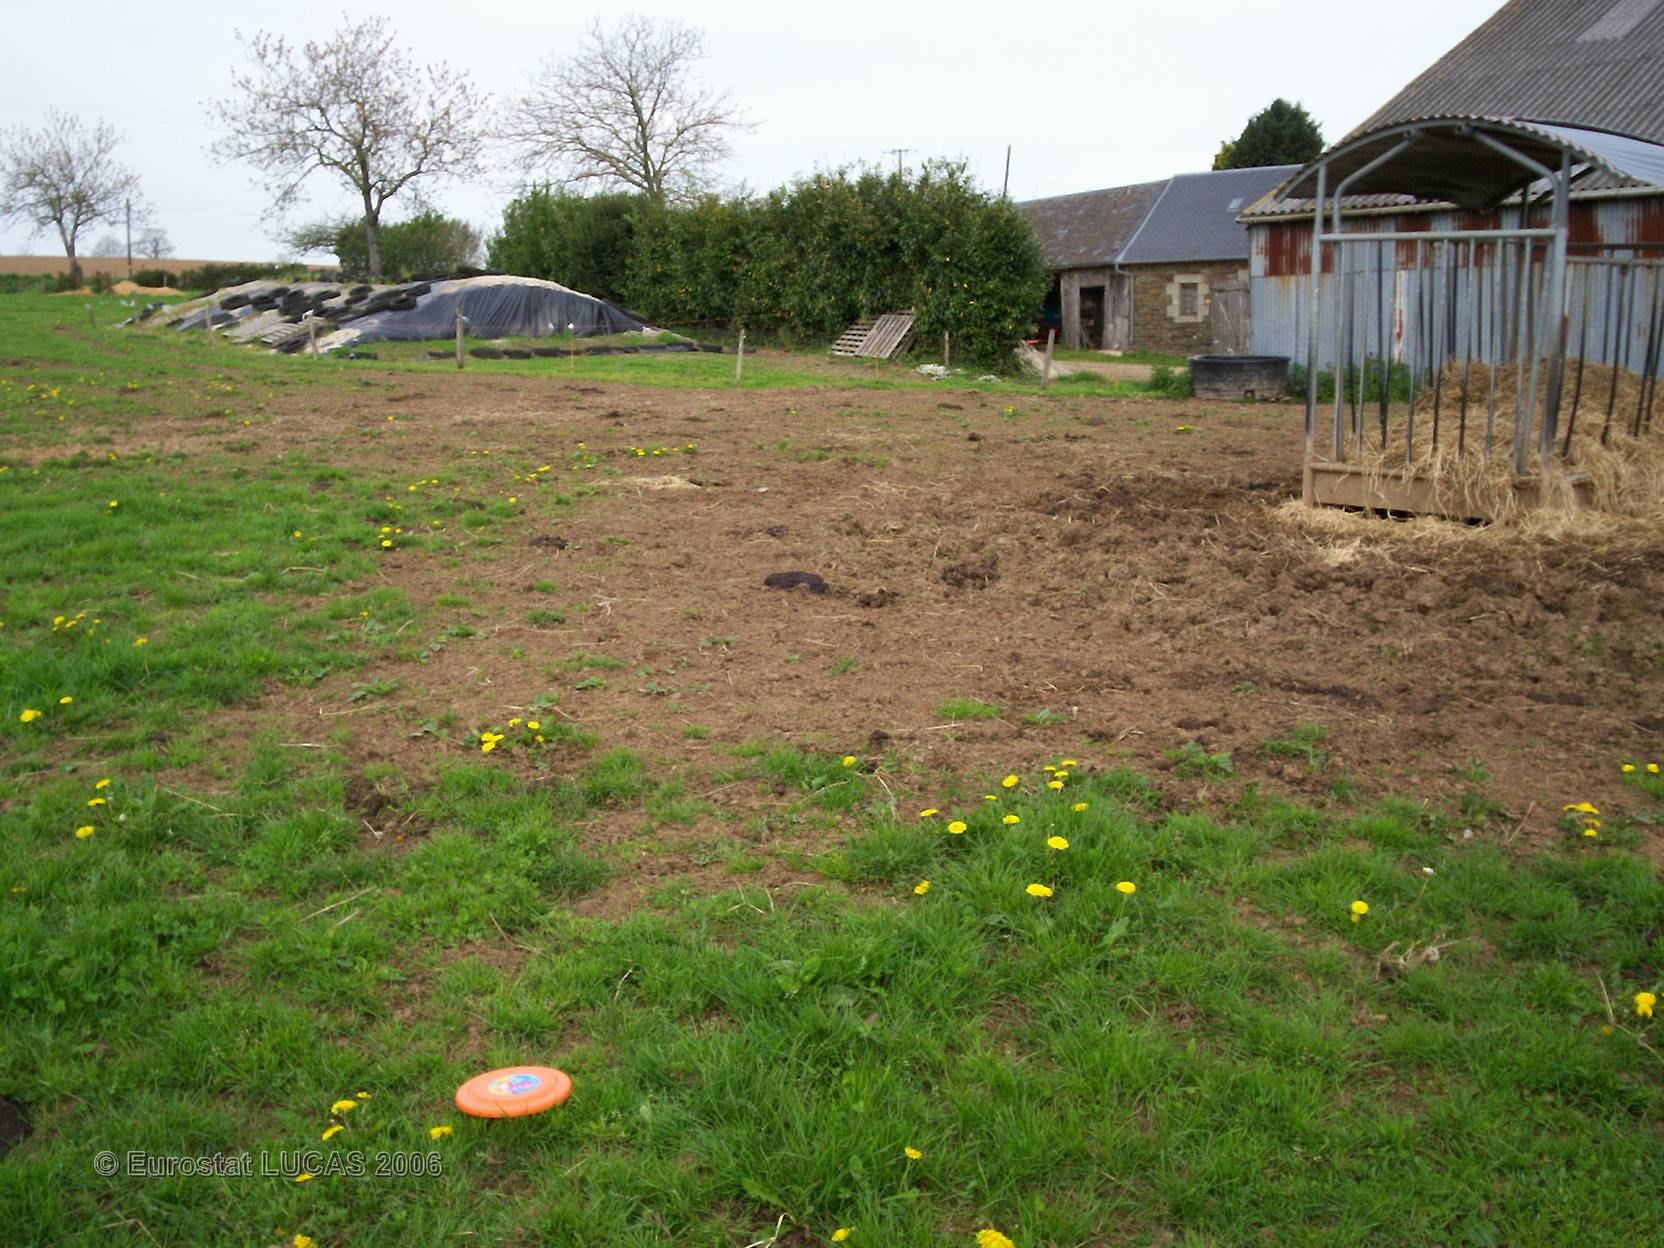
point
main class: Grassland
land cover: Grassland without tree/shrub cover
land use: Agriculture (excluding fallow land and kitchen gardens)
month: May
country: FR
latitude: 48.2063
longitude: -3.9598
